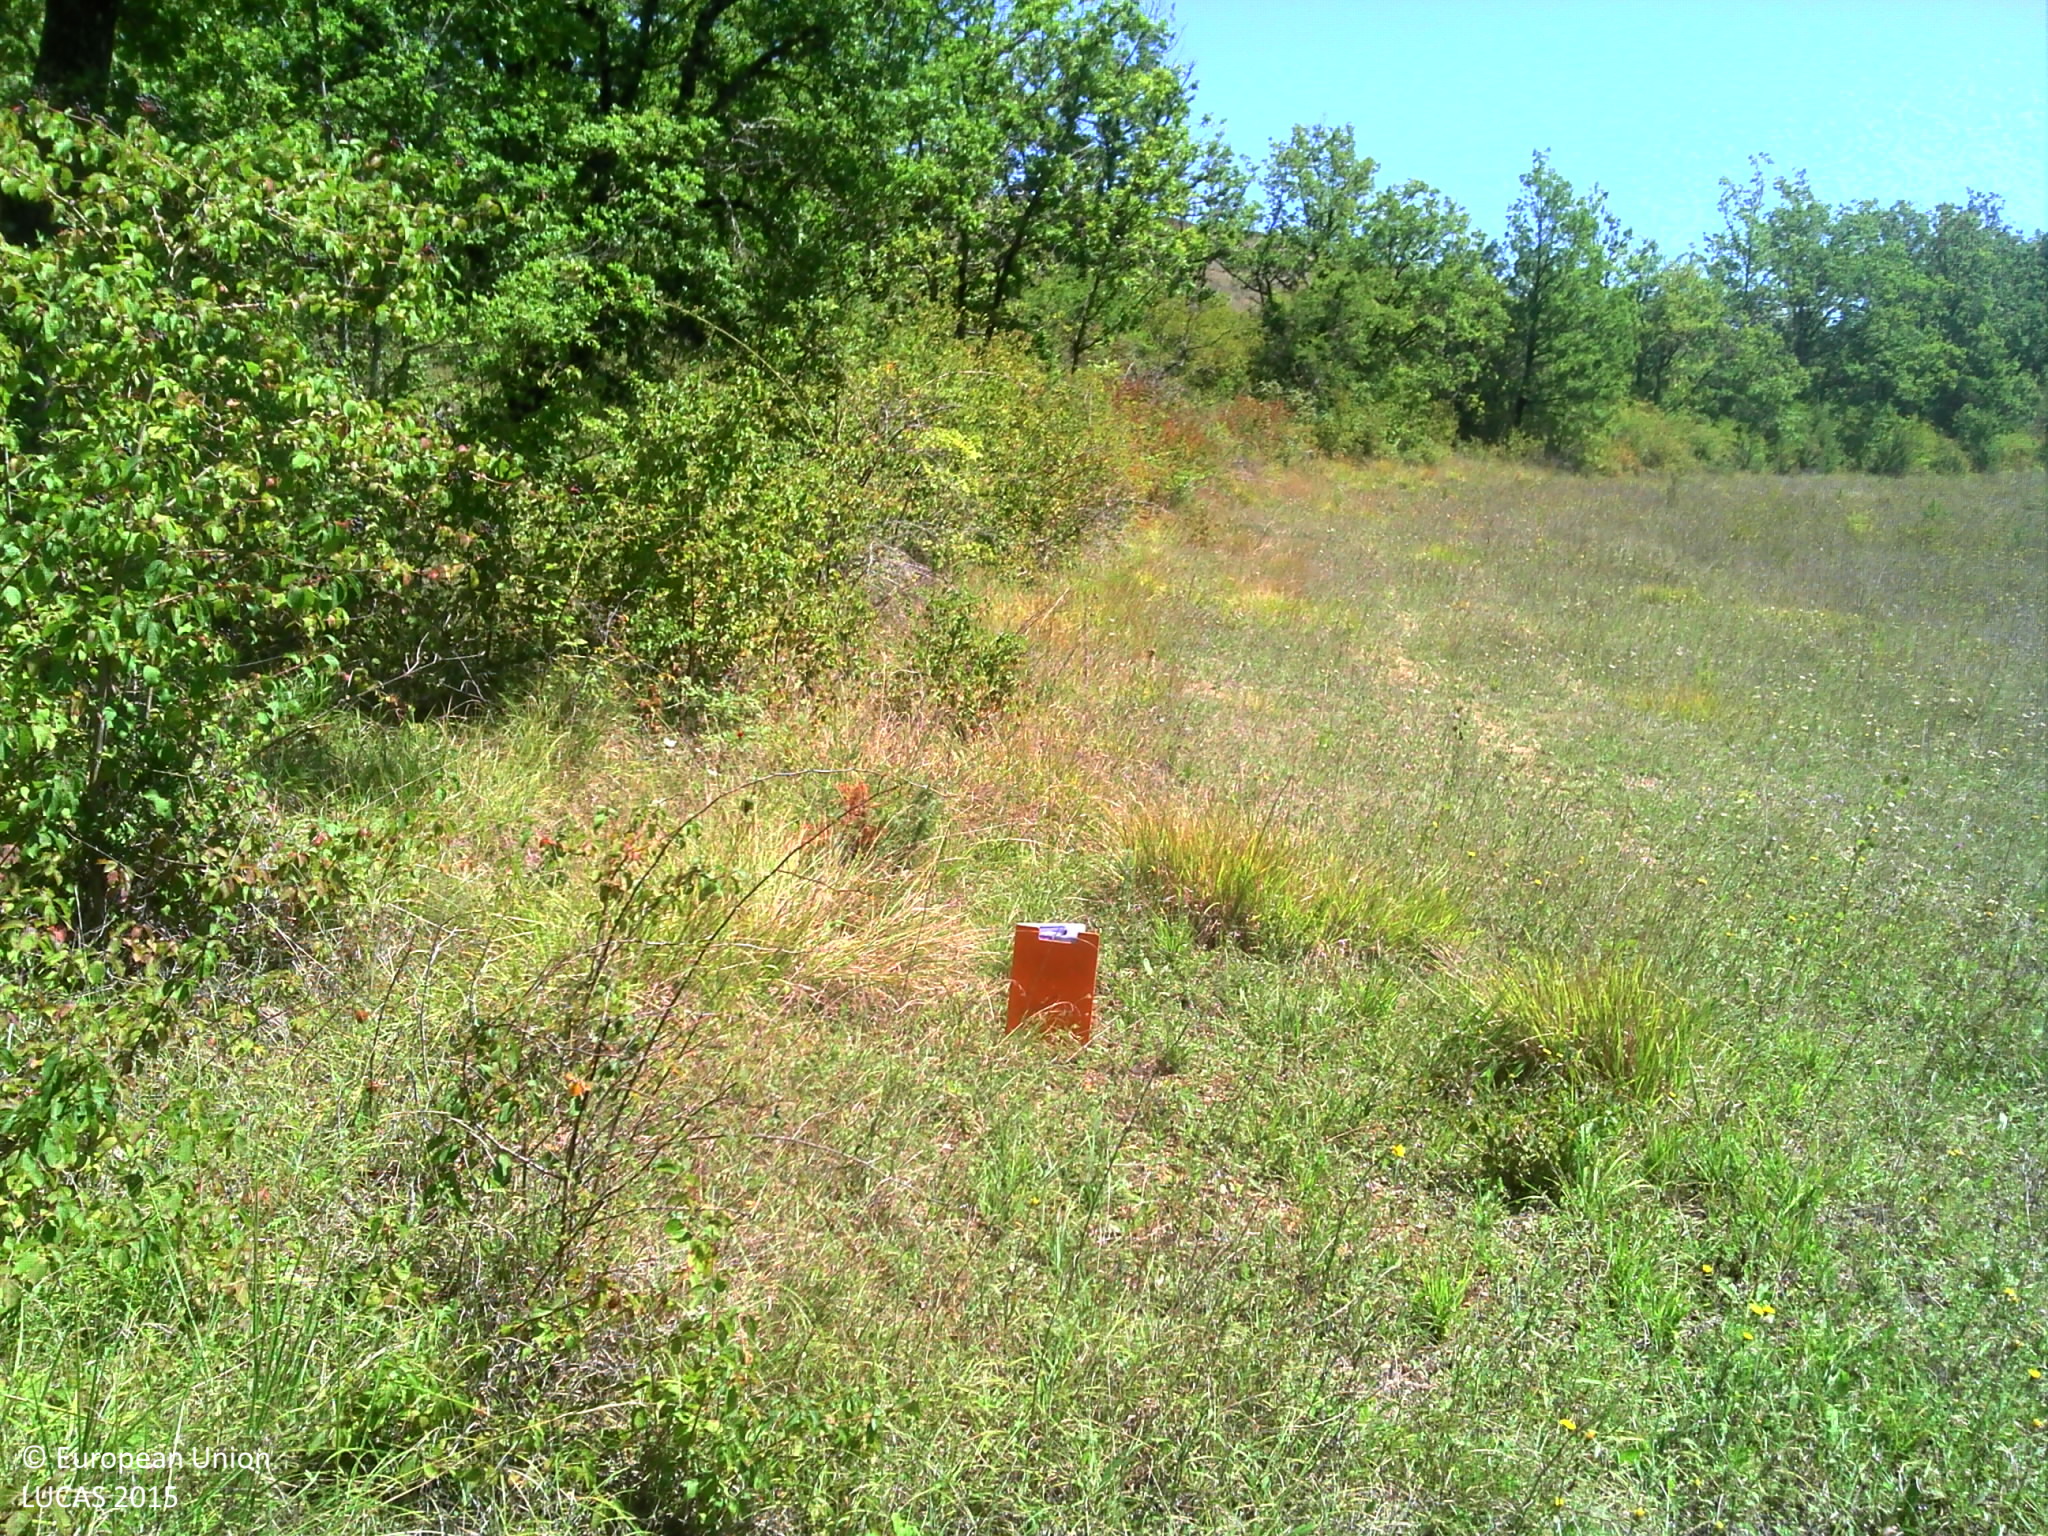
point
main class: Grassland
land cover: Grassland without tree/shrub cover
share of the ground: > 75 %
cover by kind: herbaceous plants 100 %
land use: Agriculture (excluding fallow land and kitchen gardens)
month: August
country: FR
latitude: 44.2767
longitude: 1.5423
